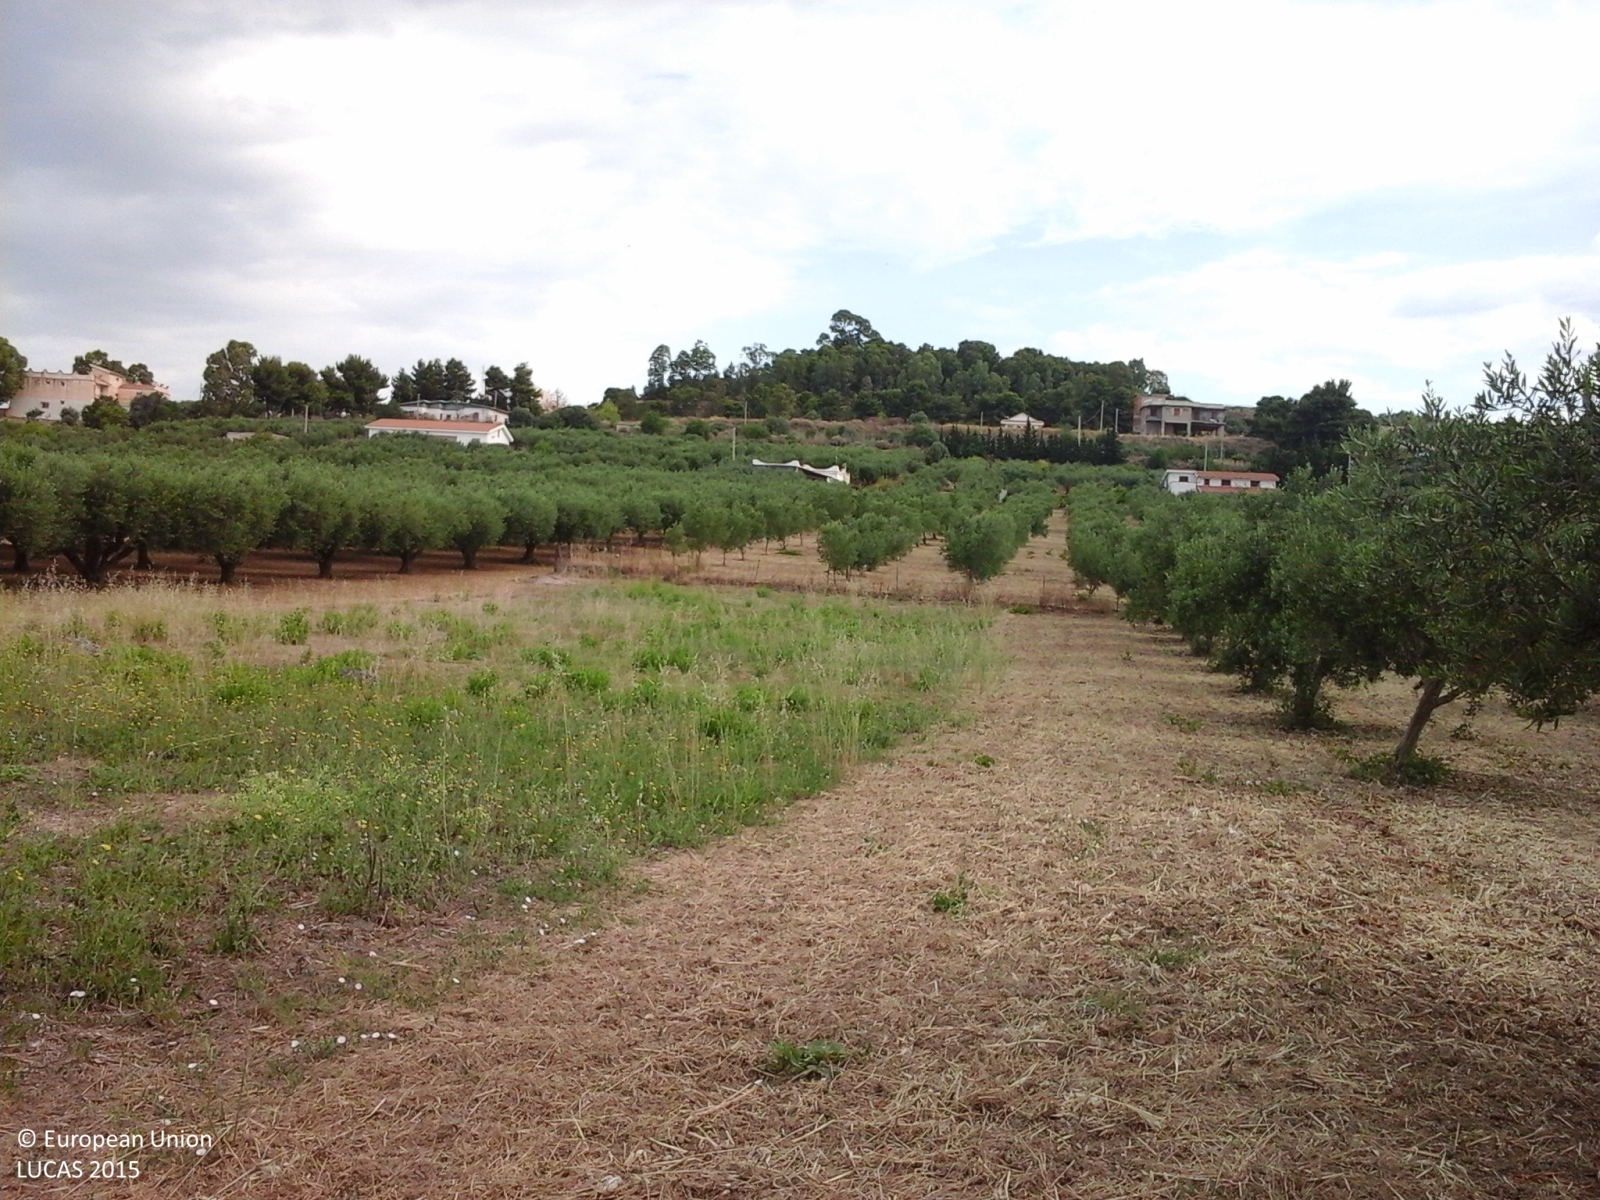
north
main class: Cropland
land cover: Olive groves
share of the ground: 25 - 50 %
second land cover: Grassland without tree/shrub cover
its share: > 75 %
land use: Agriculture (excluding fallow land and kitchen gardens)
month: June
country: IT
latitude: 37.4947
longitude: 13.1765
